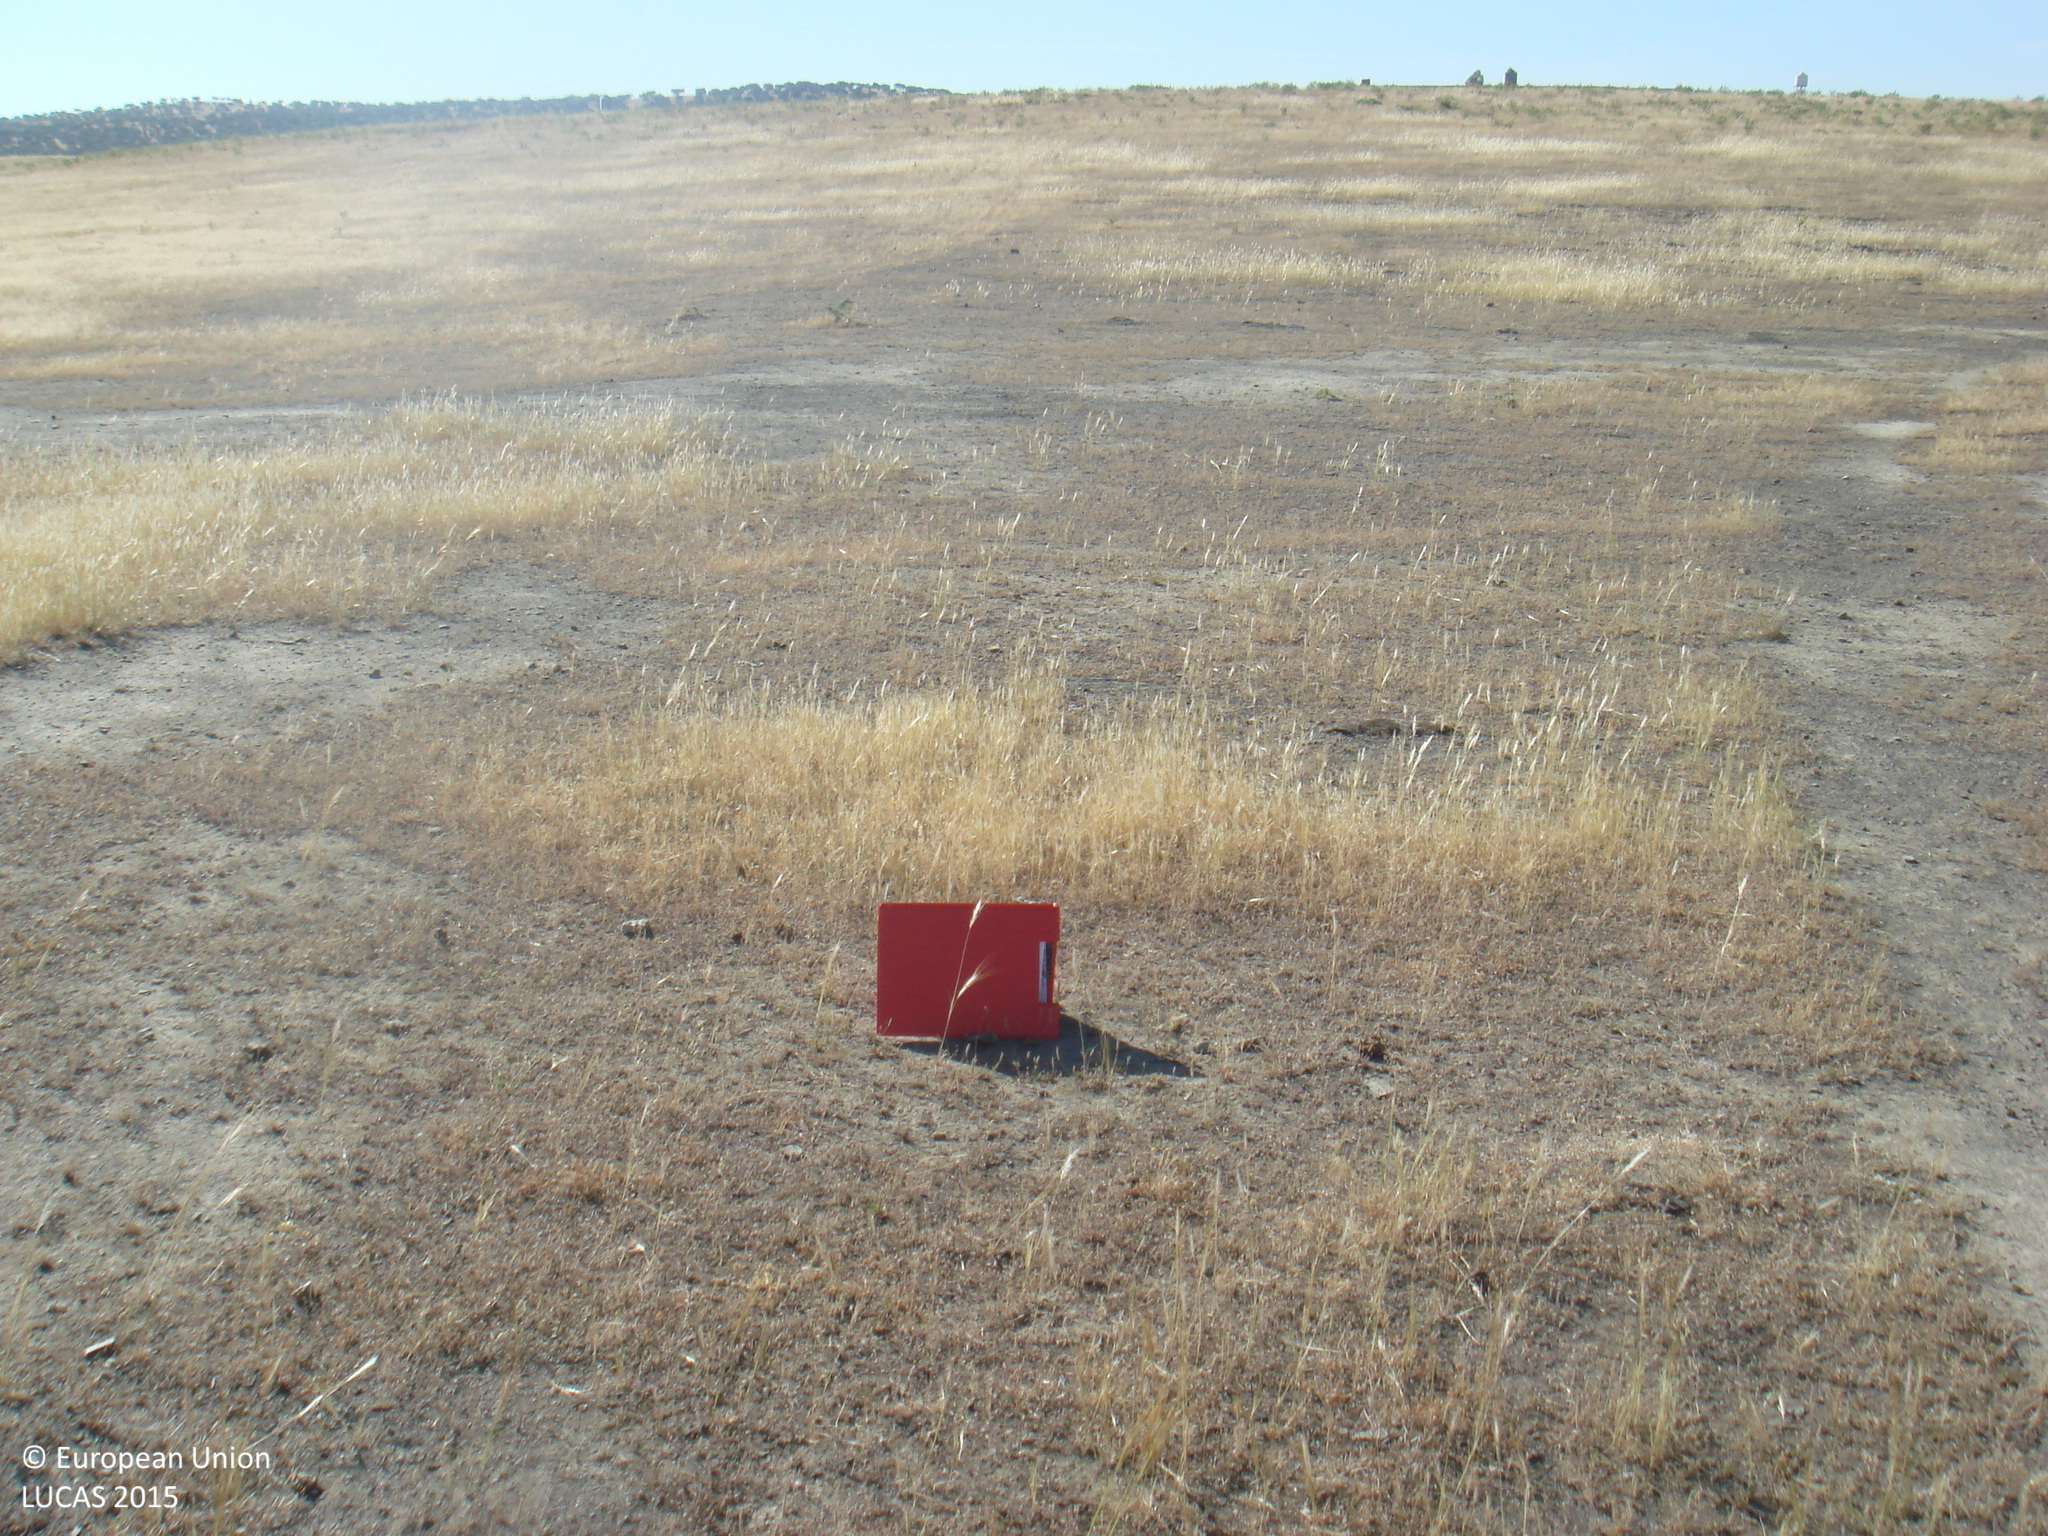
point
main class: Grassland
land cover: Spontaneously vegetated surfaces
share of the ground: > 75 %
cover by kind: herbaceous plants 100 %
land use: Agriculture (excluding fallow land and kitchen gardens)
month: May
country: ES
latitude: 38.5975
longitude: -5.0832
